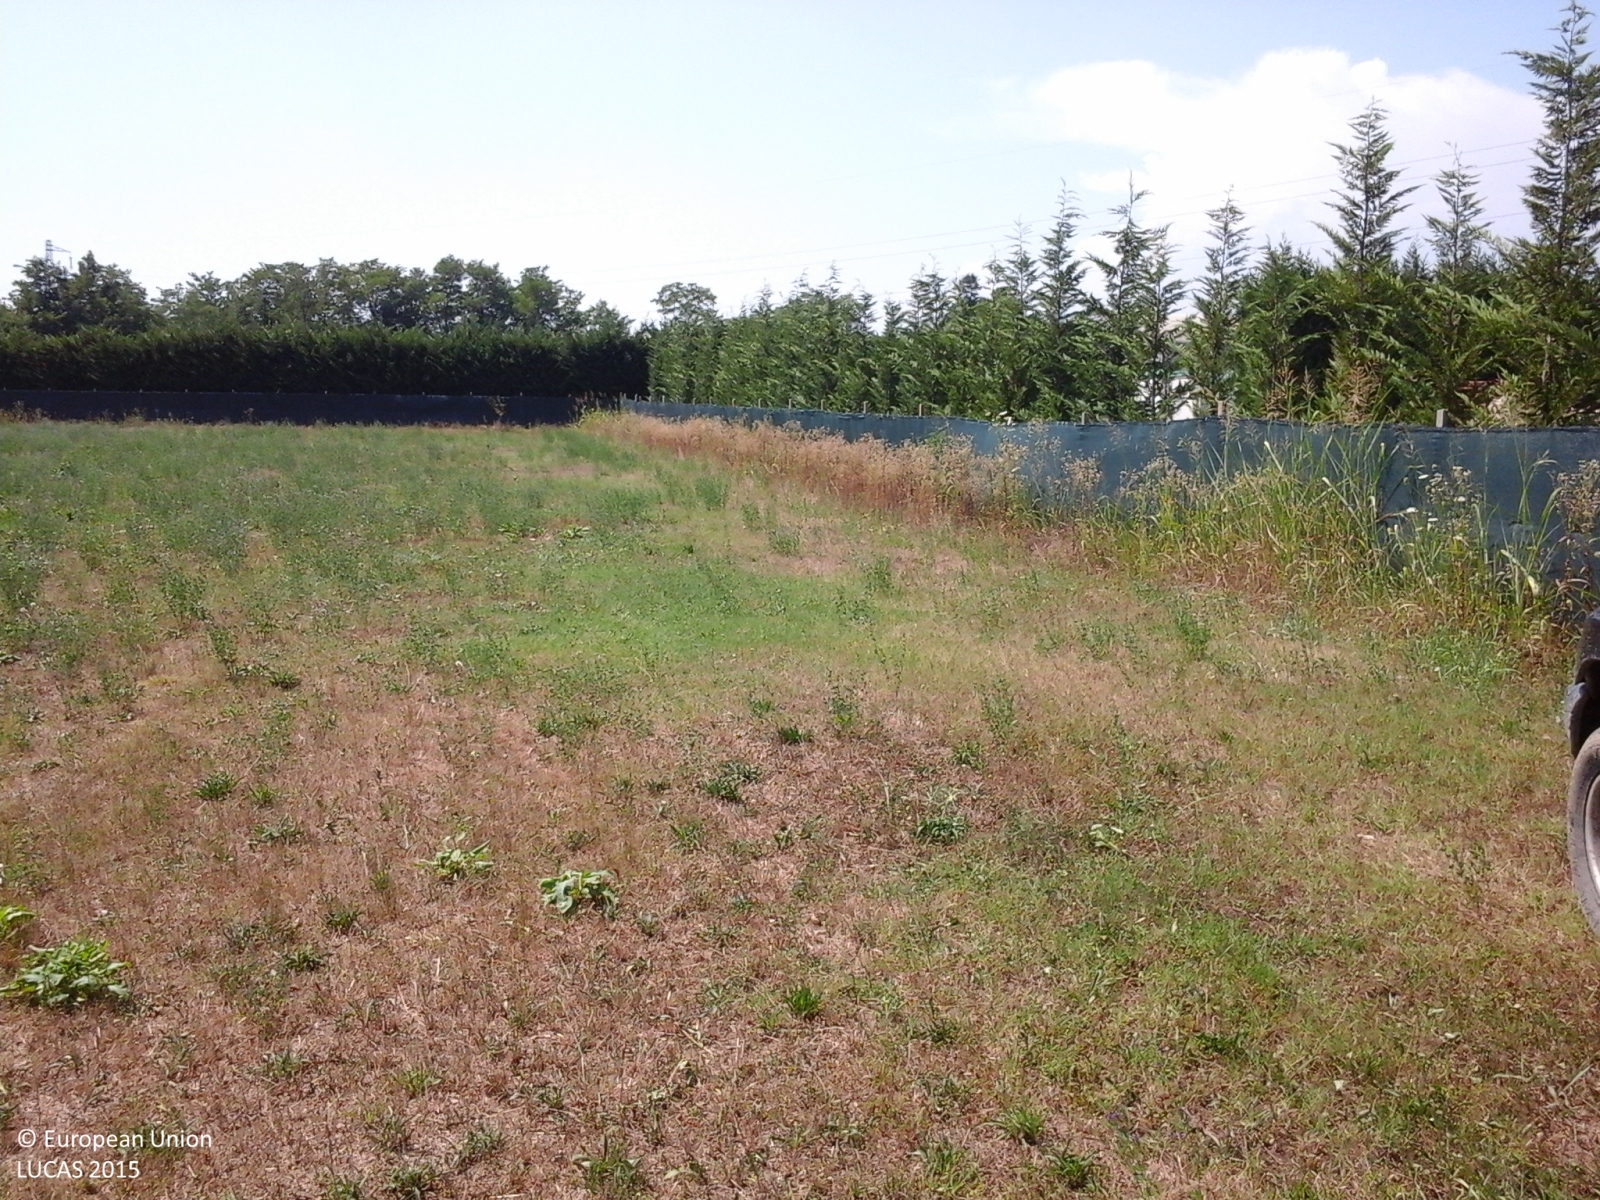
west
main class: Grassland
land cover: Grassland without tree/shrub cover
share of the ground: > 75 %
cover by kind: herbaceous plants 100 %
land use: Agriculture (excluding fallow land and kitchen gardens)
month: July
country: IT
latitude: 45.7318
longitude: 12.2969
